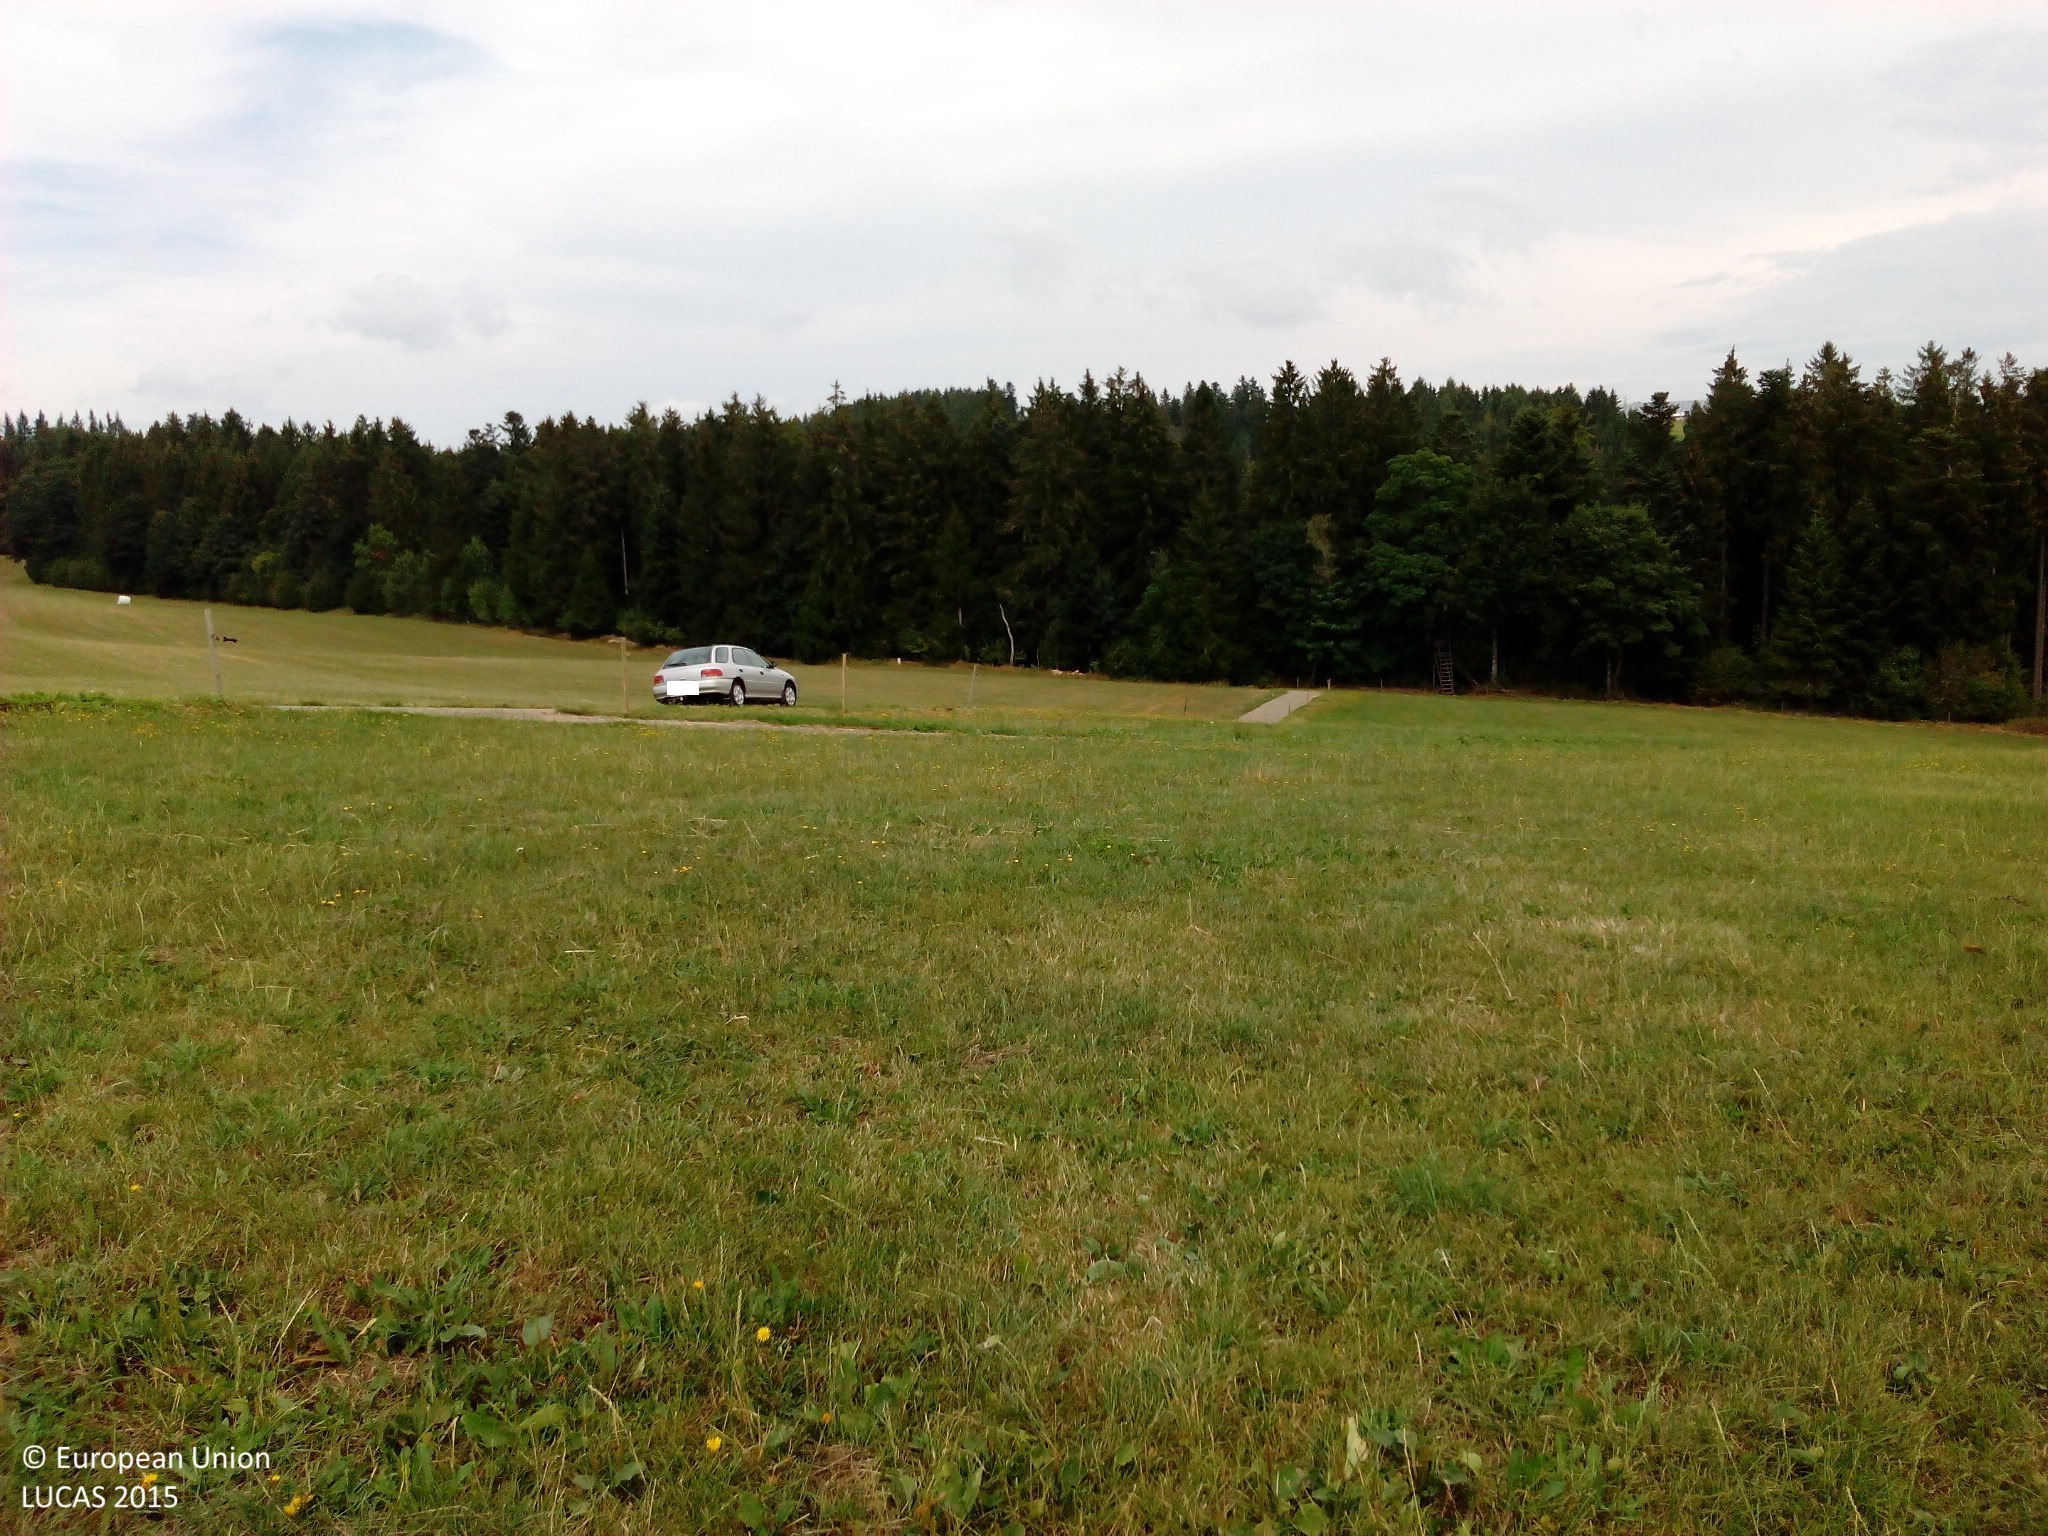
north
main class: Grassland
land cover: Grassland without tree/shrub cover
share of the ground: > 75 %
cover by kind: herbaceous plants 100 %
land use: Agriculture (excluding fallow land and kitchen gardens)
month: August
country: DE
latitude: 47.7040
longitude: 8.1489
